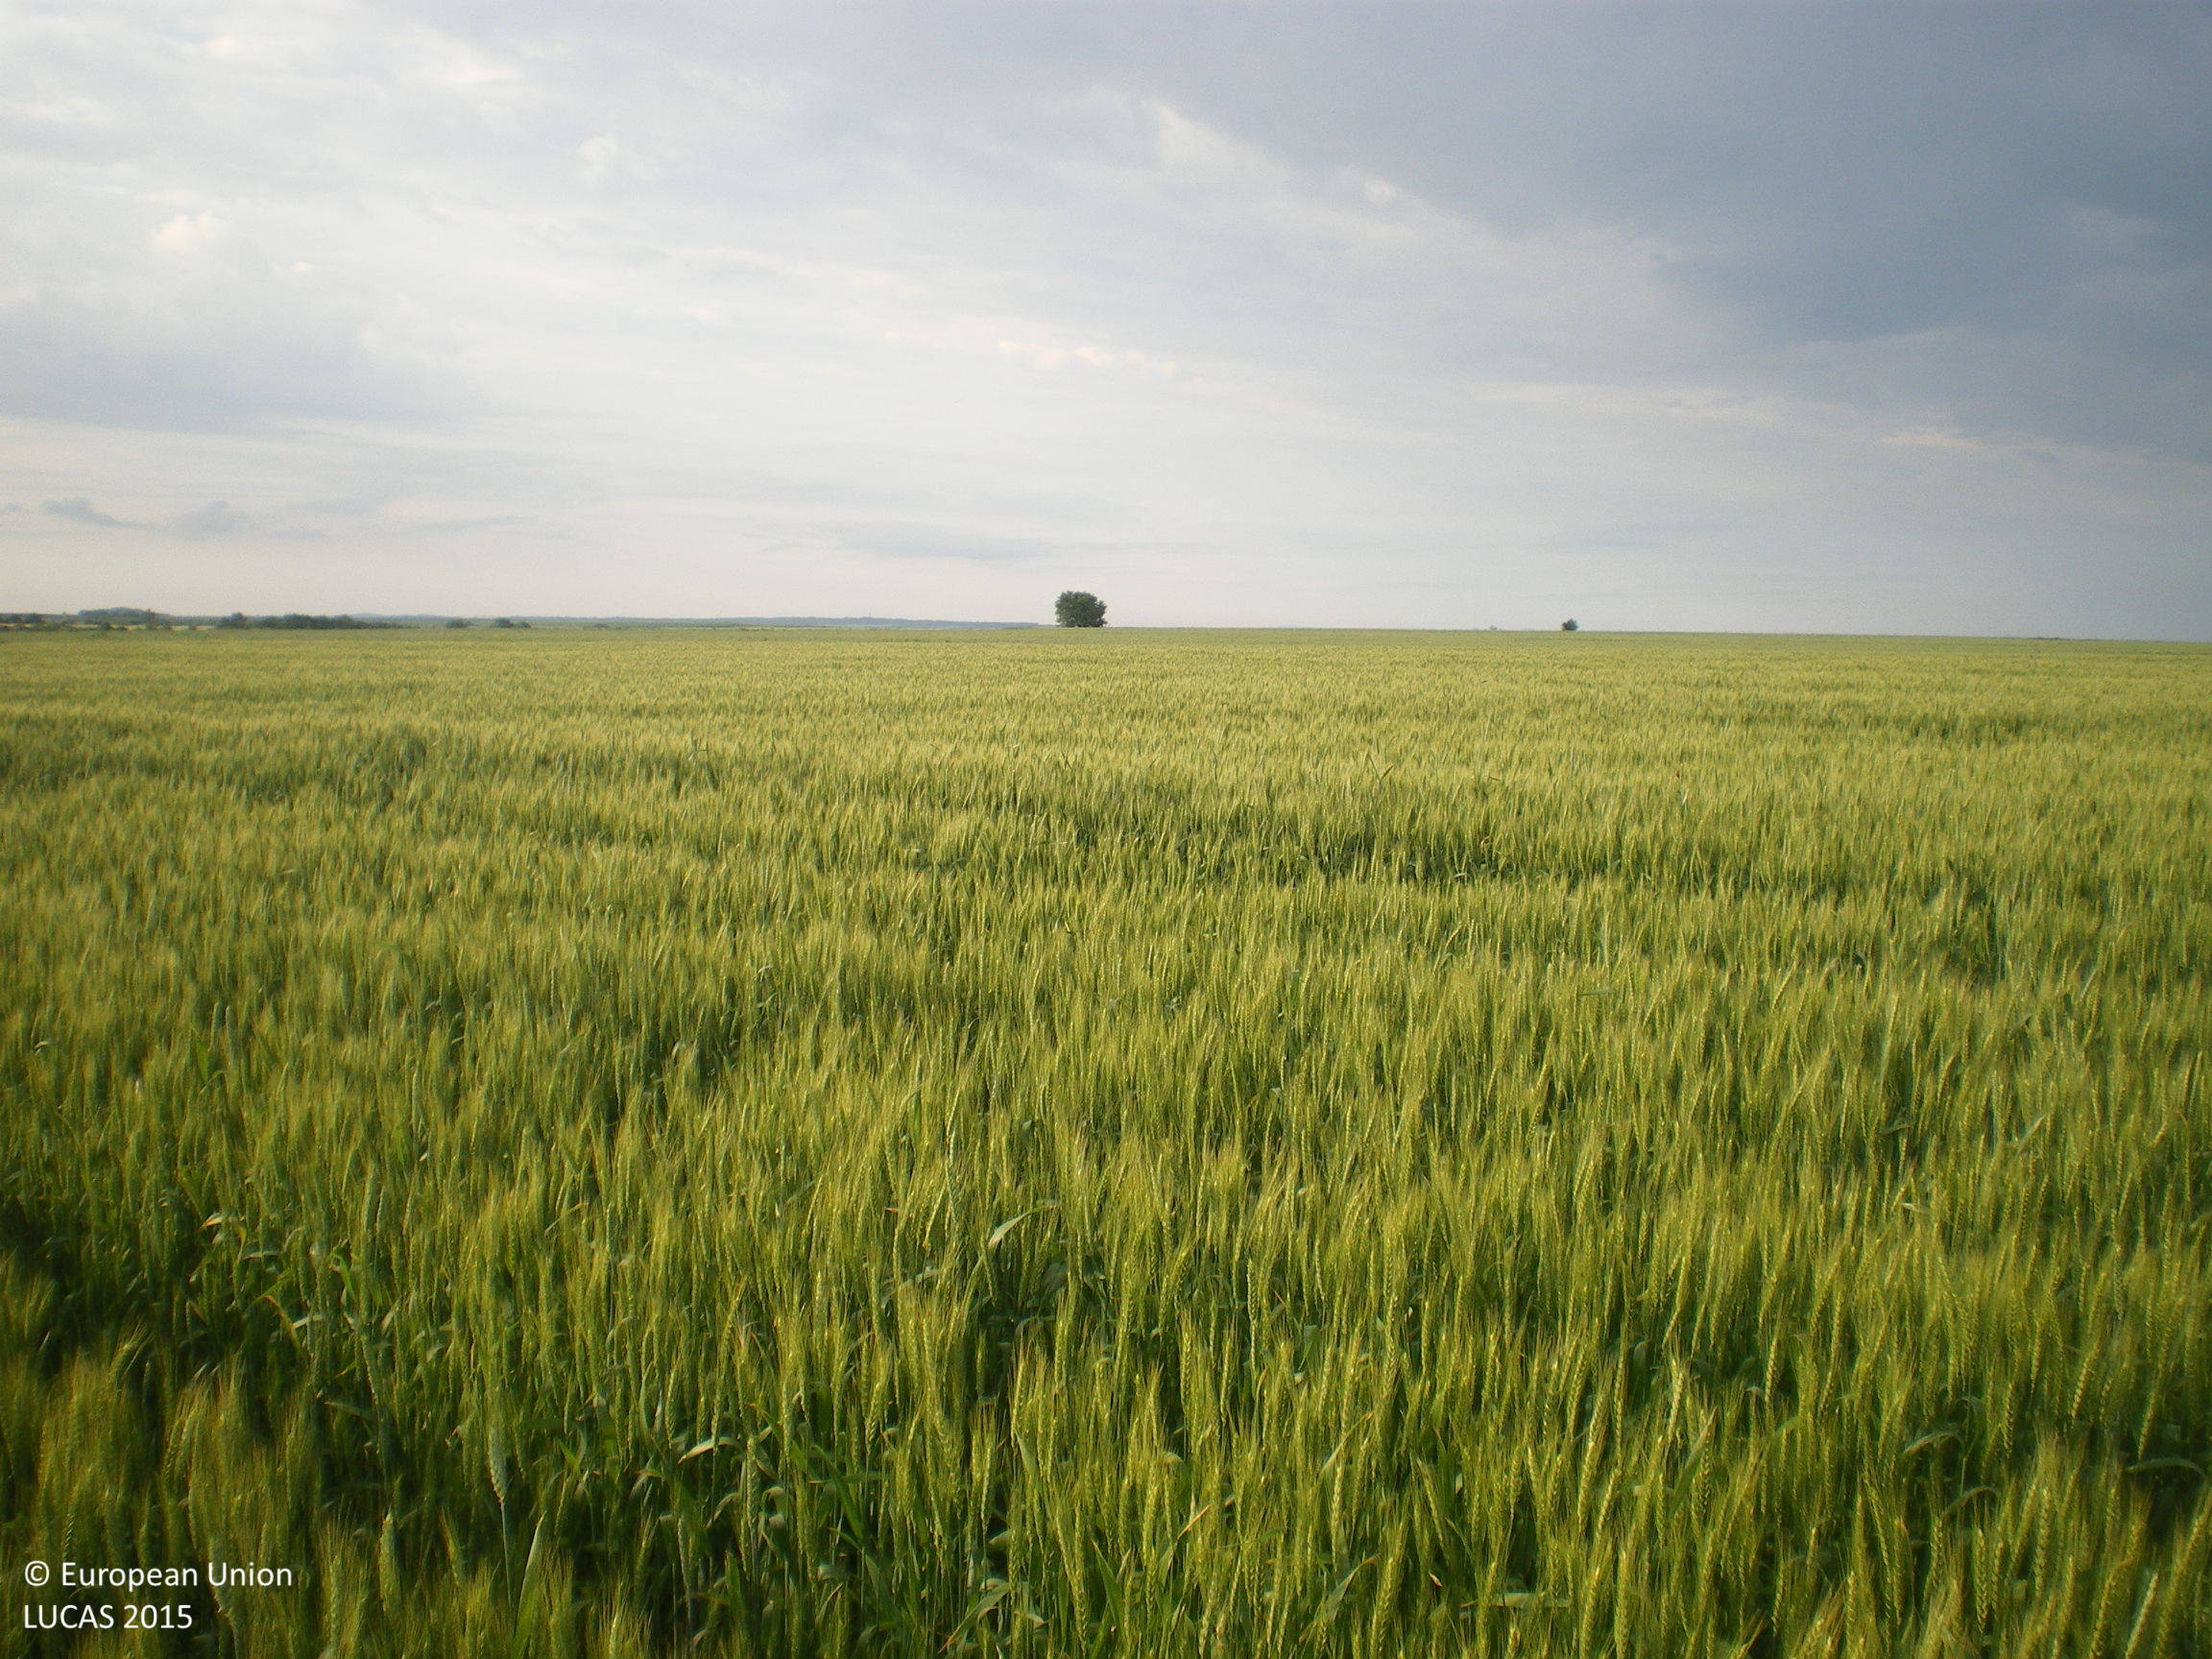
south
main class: Cropland
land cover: Common wheat
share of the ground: > 75 %
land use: Agriculture (excluding fallow land and kitchen gardens)
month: May
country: BG
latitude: 42.1971
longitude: 25.4330
